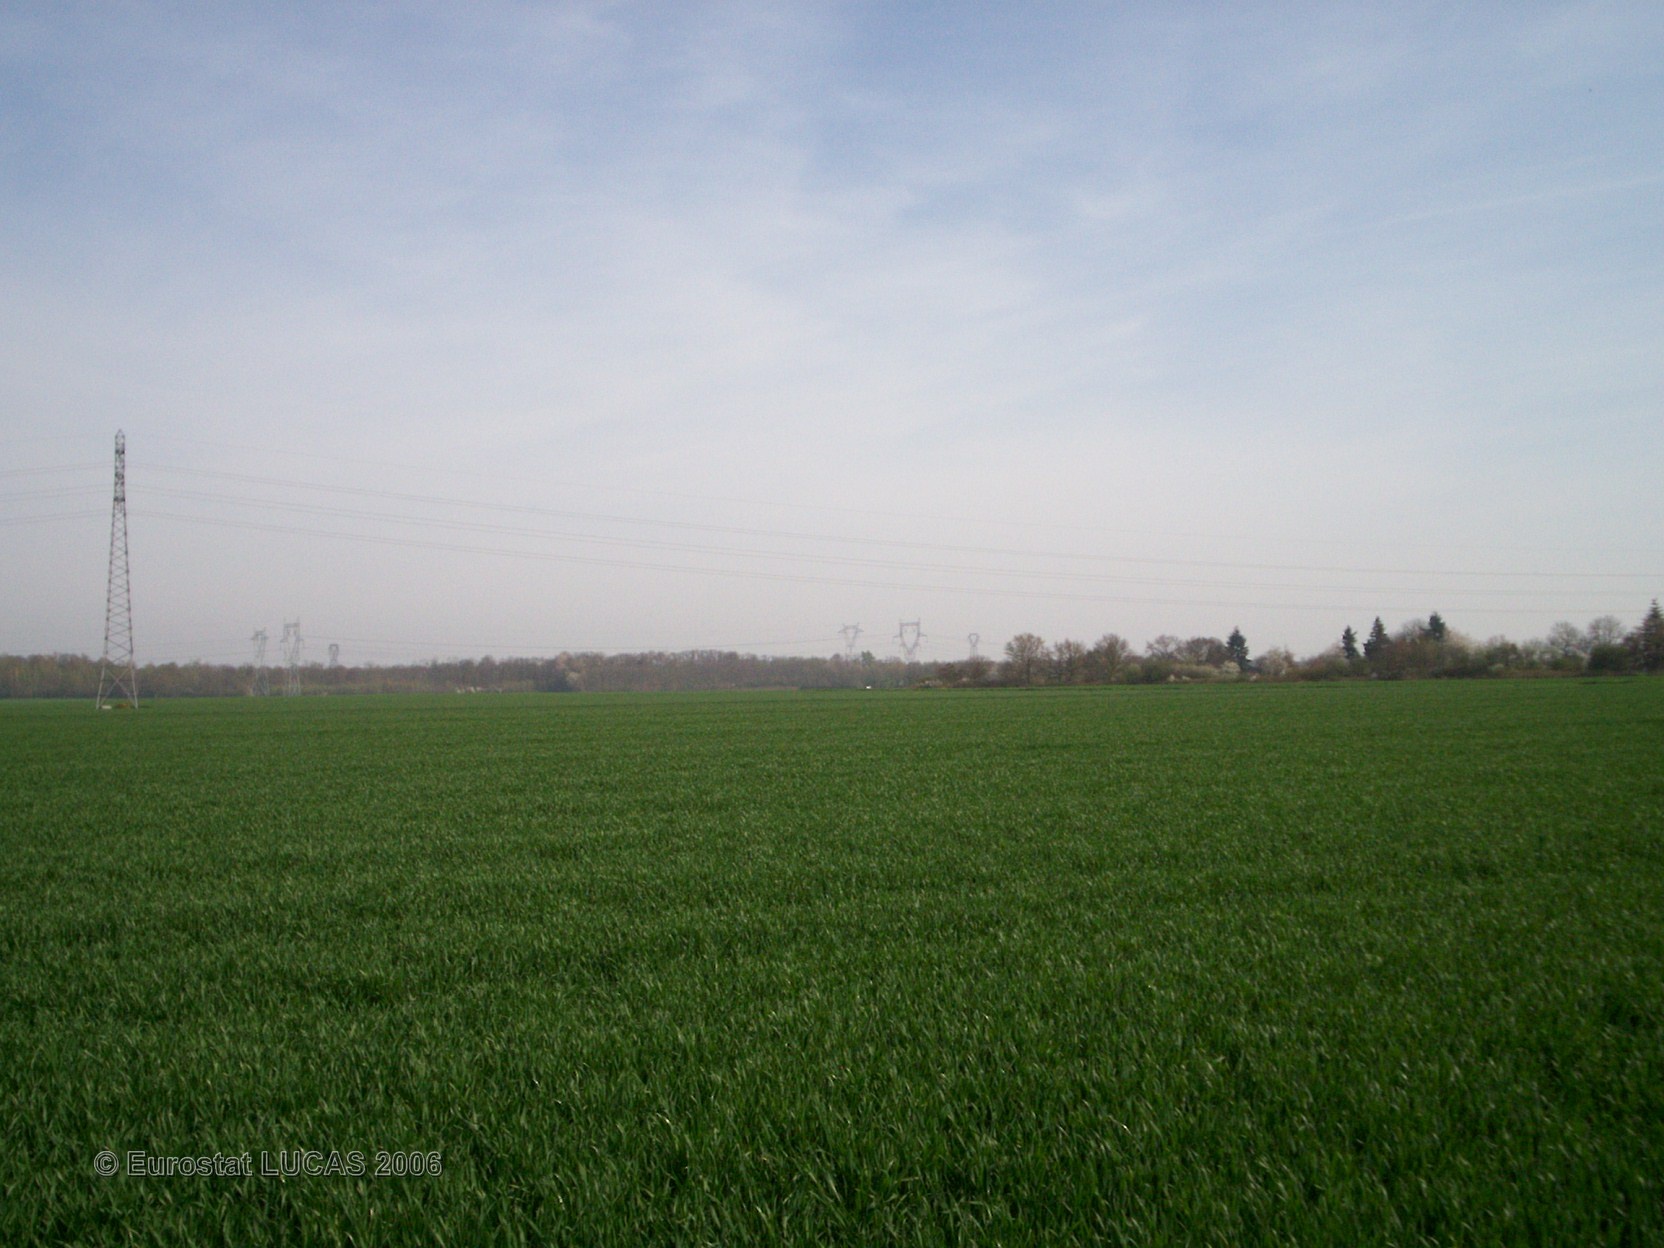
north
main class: Cropland
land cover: Barley
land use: Agriculture (excluding fallow land and kitchen gardens)
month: April
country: FR
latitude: 48.3920
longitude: 2.9015
